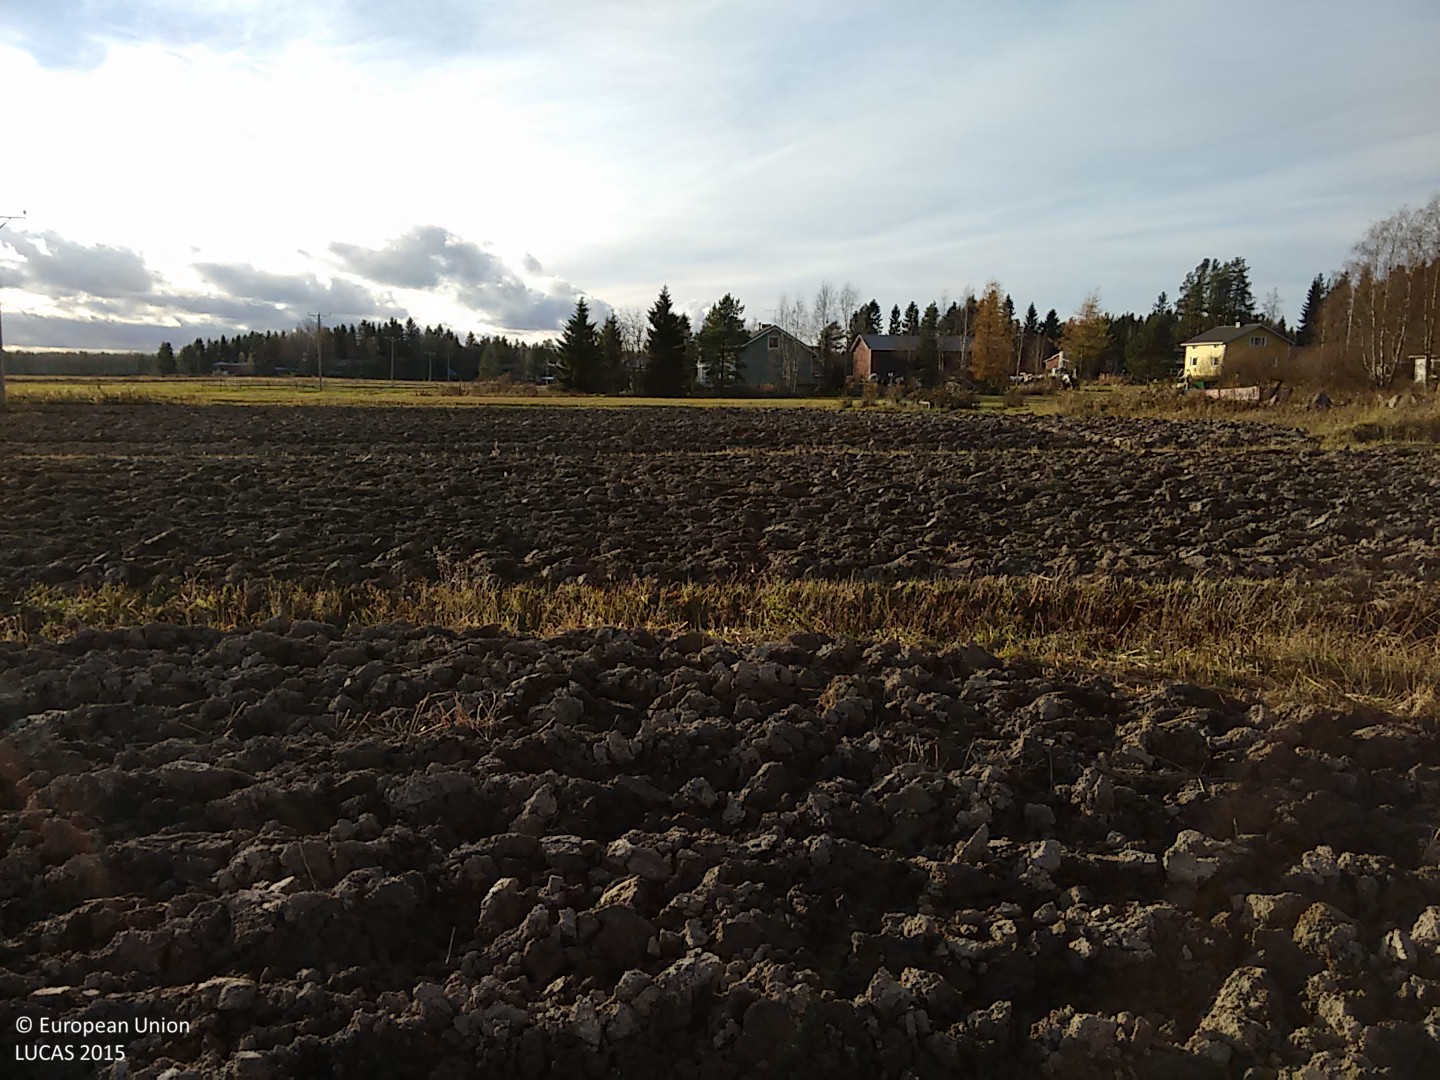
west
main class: Cropland
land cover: Barley
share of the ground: < 10 %
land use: Agriculture (excluding fallow land and kitchen gardens)
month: October
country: FI
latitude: 63.9615
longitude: 25.1360
